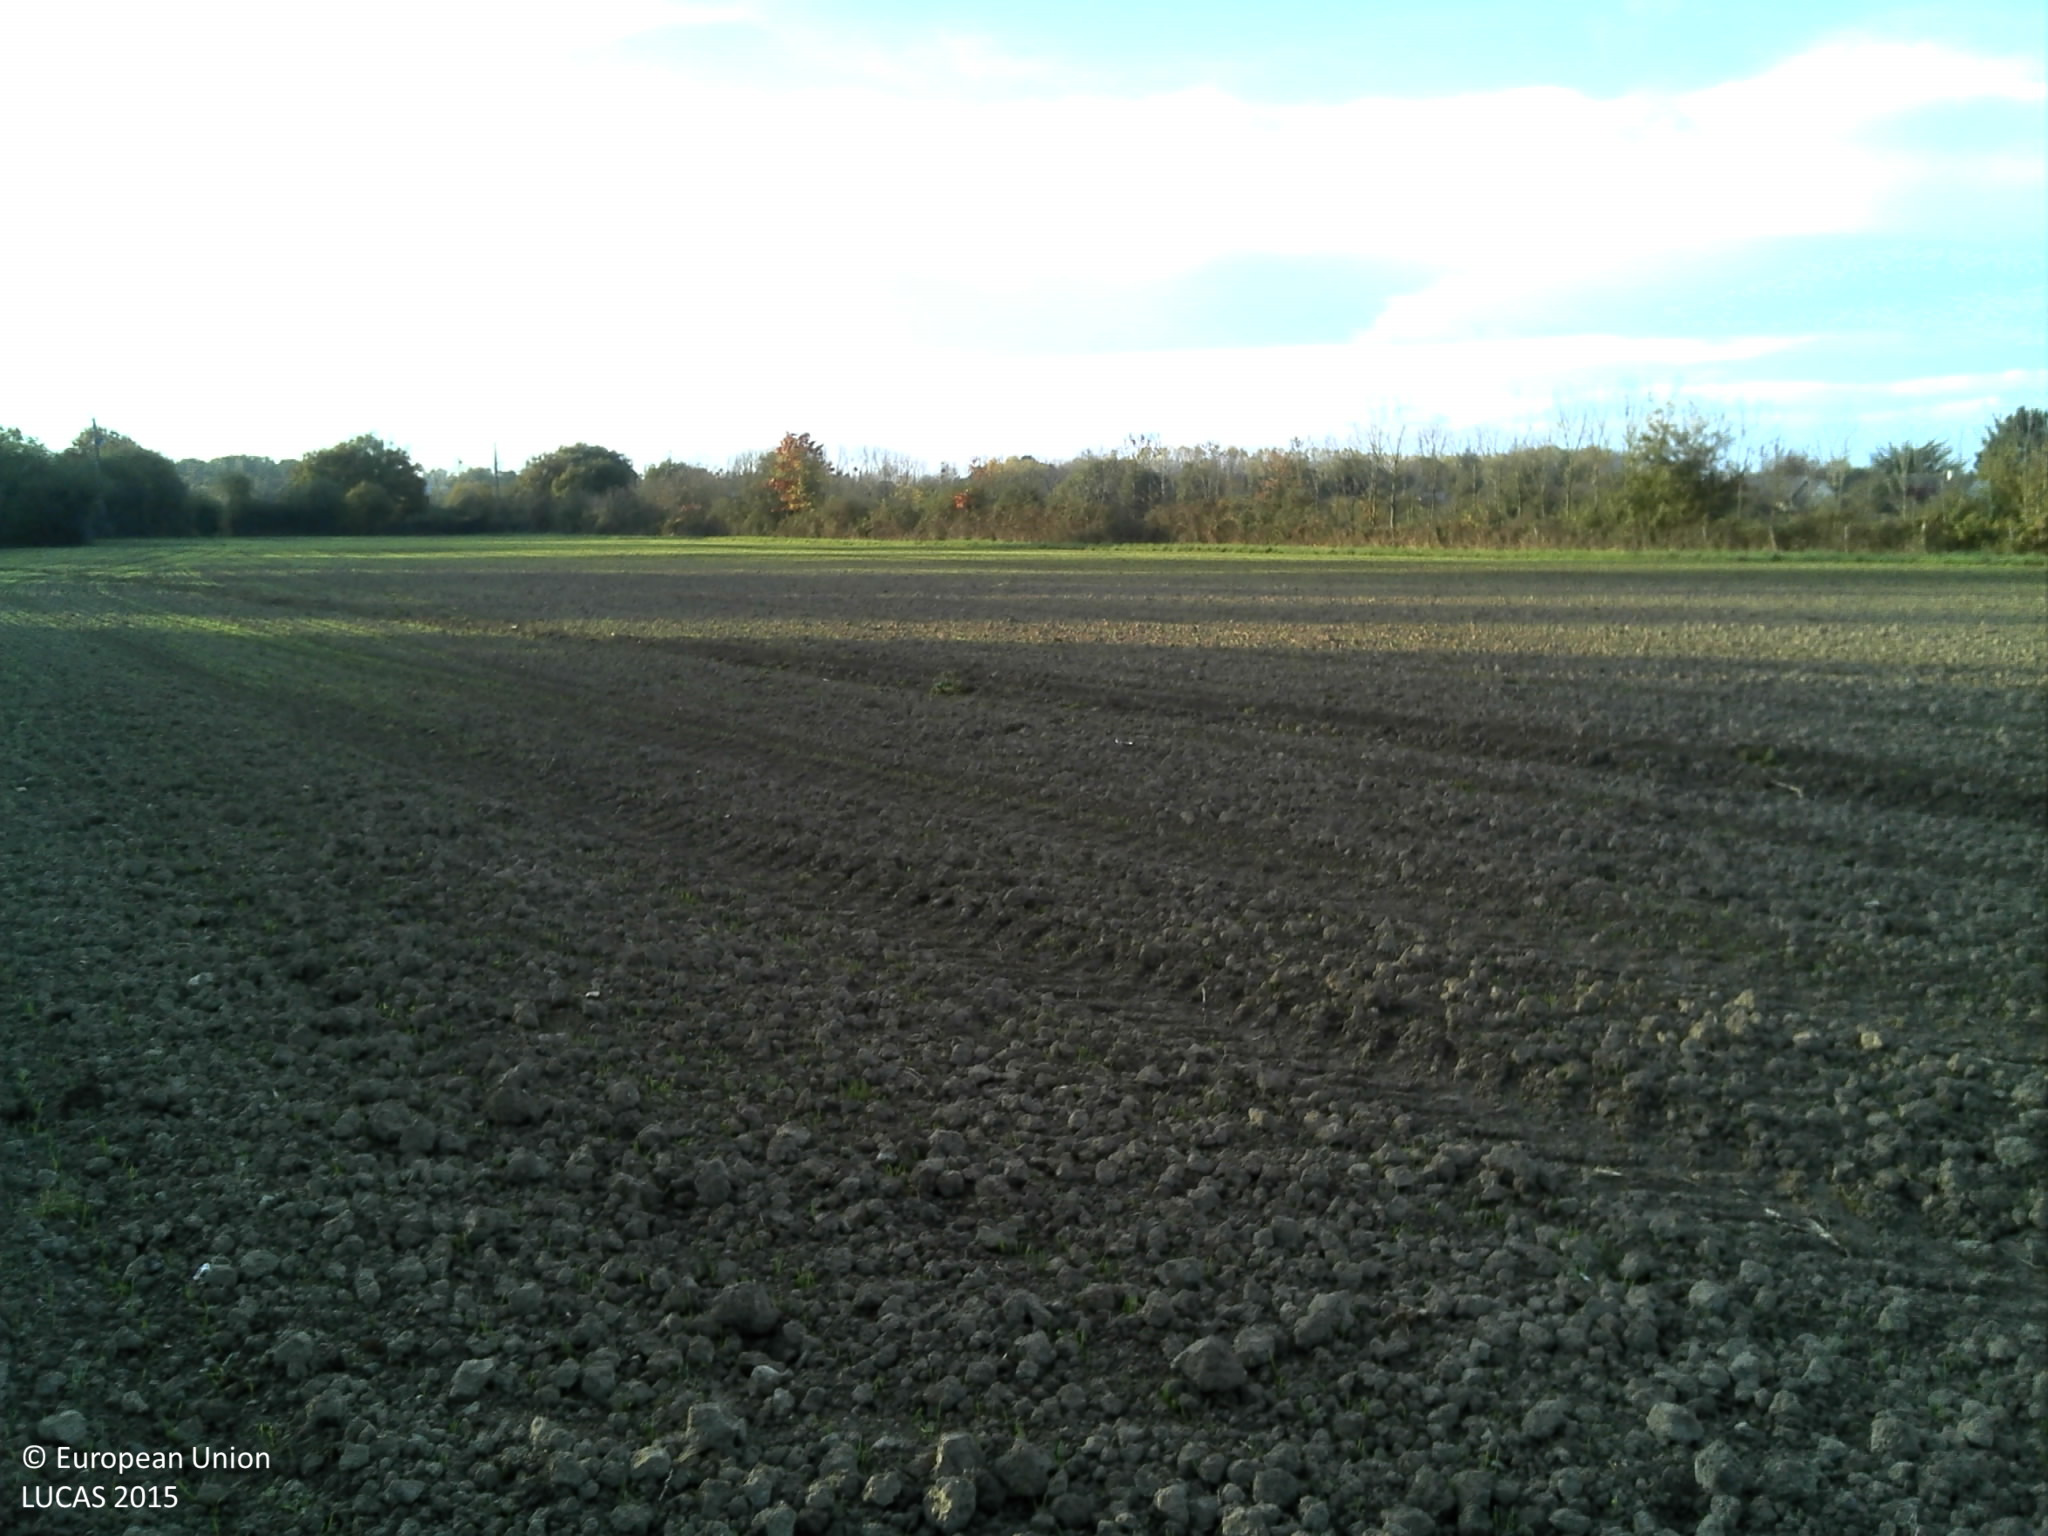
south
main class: Cropland
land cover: Common wheat
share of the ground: < 10 %
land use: Agriculture (excluding fallow land and kitchen gardens)
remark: Tilled/Sowed
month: November
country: FR
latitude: 47.5772
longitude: -1.0321
